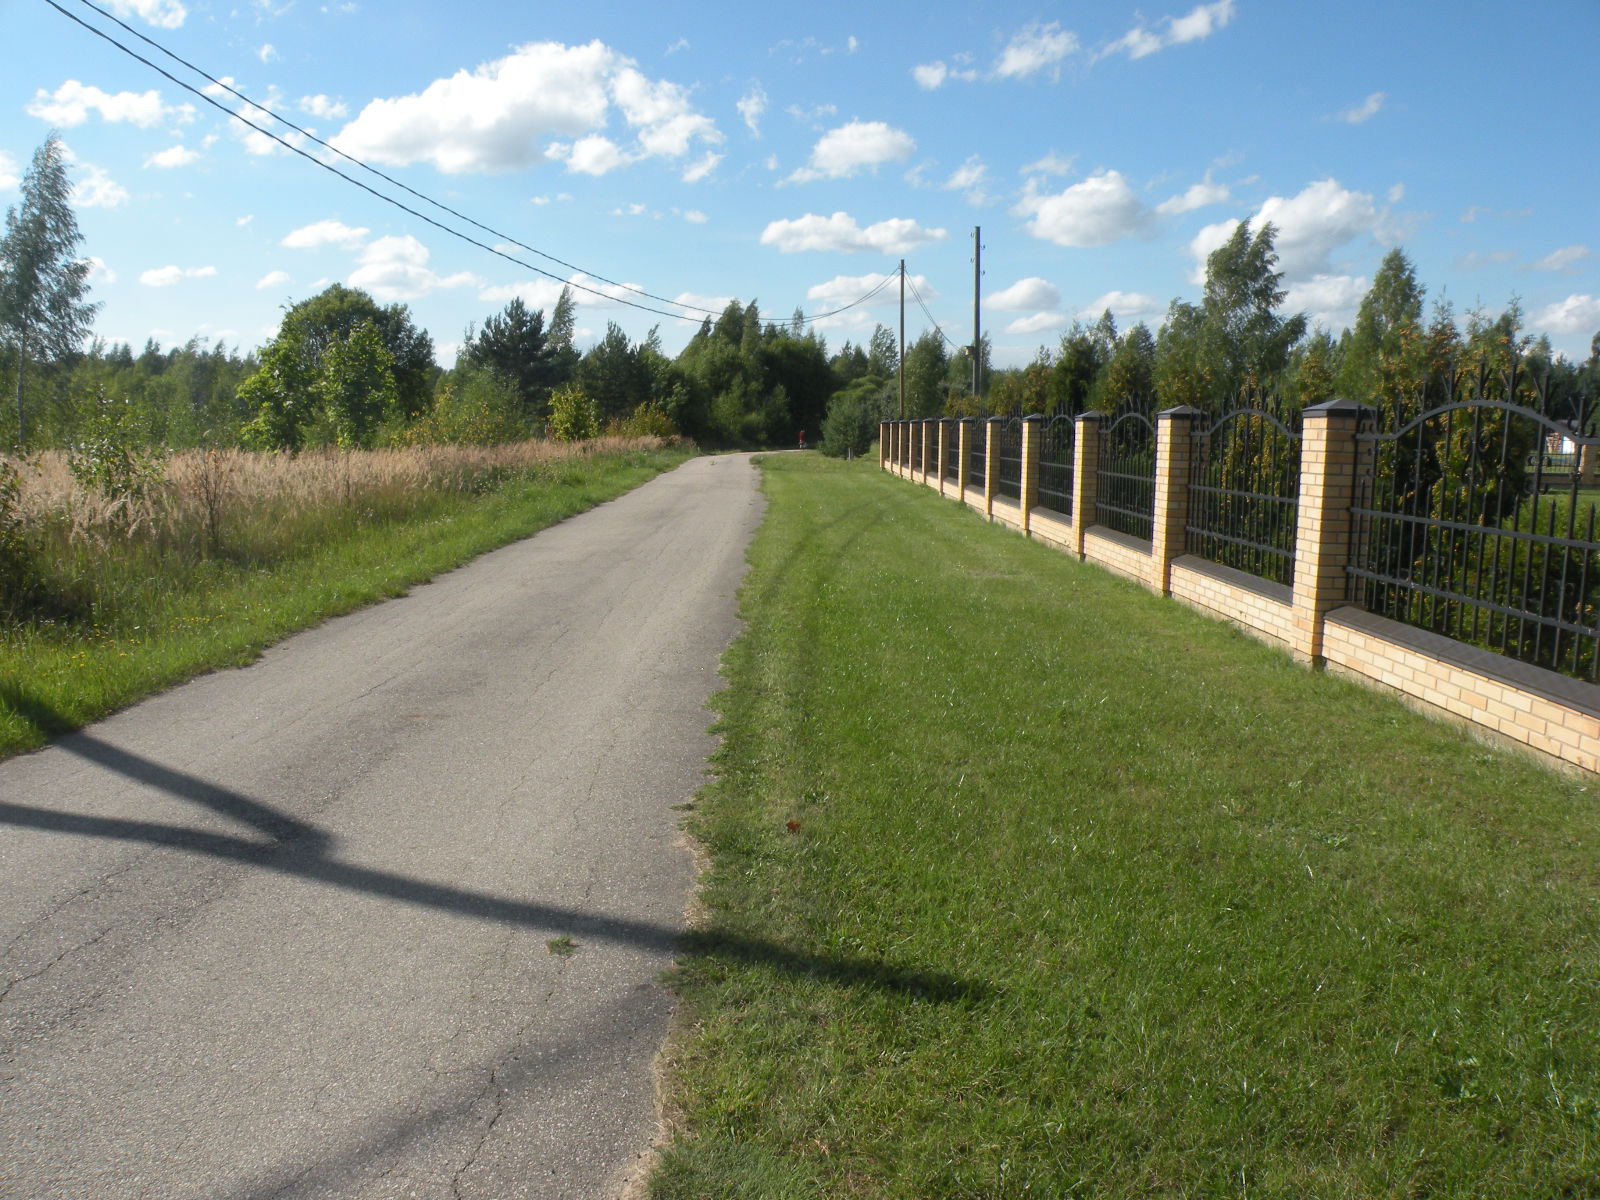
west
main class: Grassland
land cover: Grassland without tree/shrub cover
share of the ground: > 75 %
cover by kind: herbaceous plants 100 %
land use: Residential
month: September
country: LV
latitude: 55.9206
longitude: 26.6200
